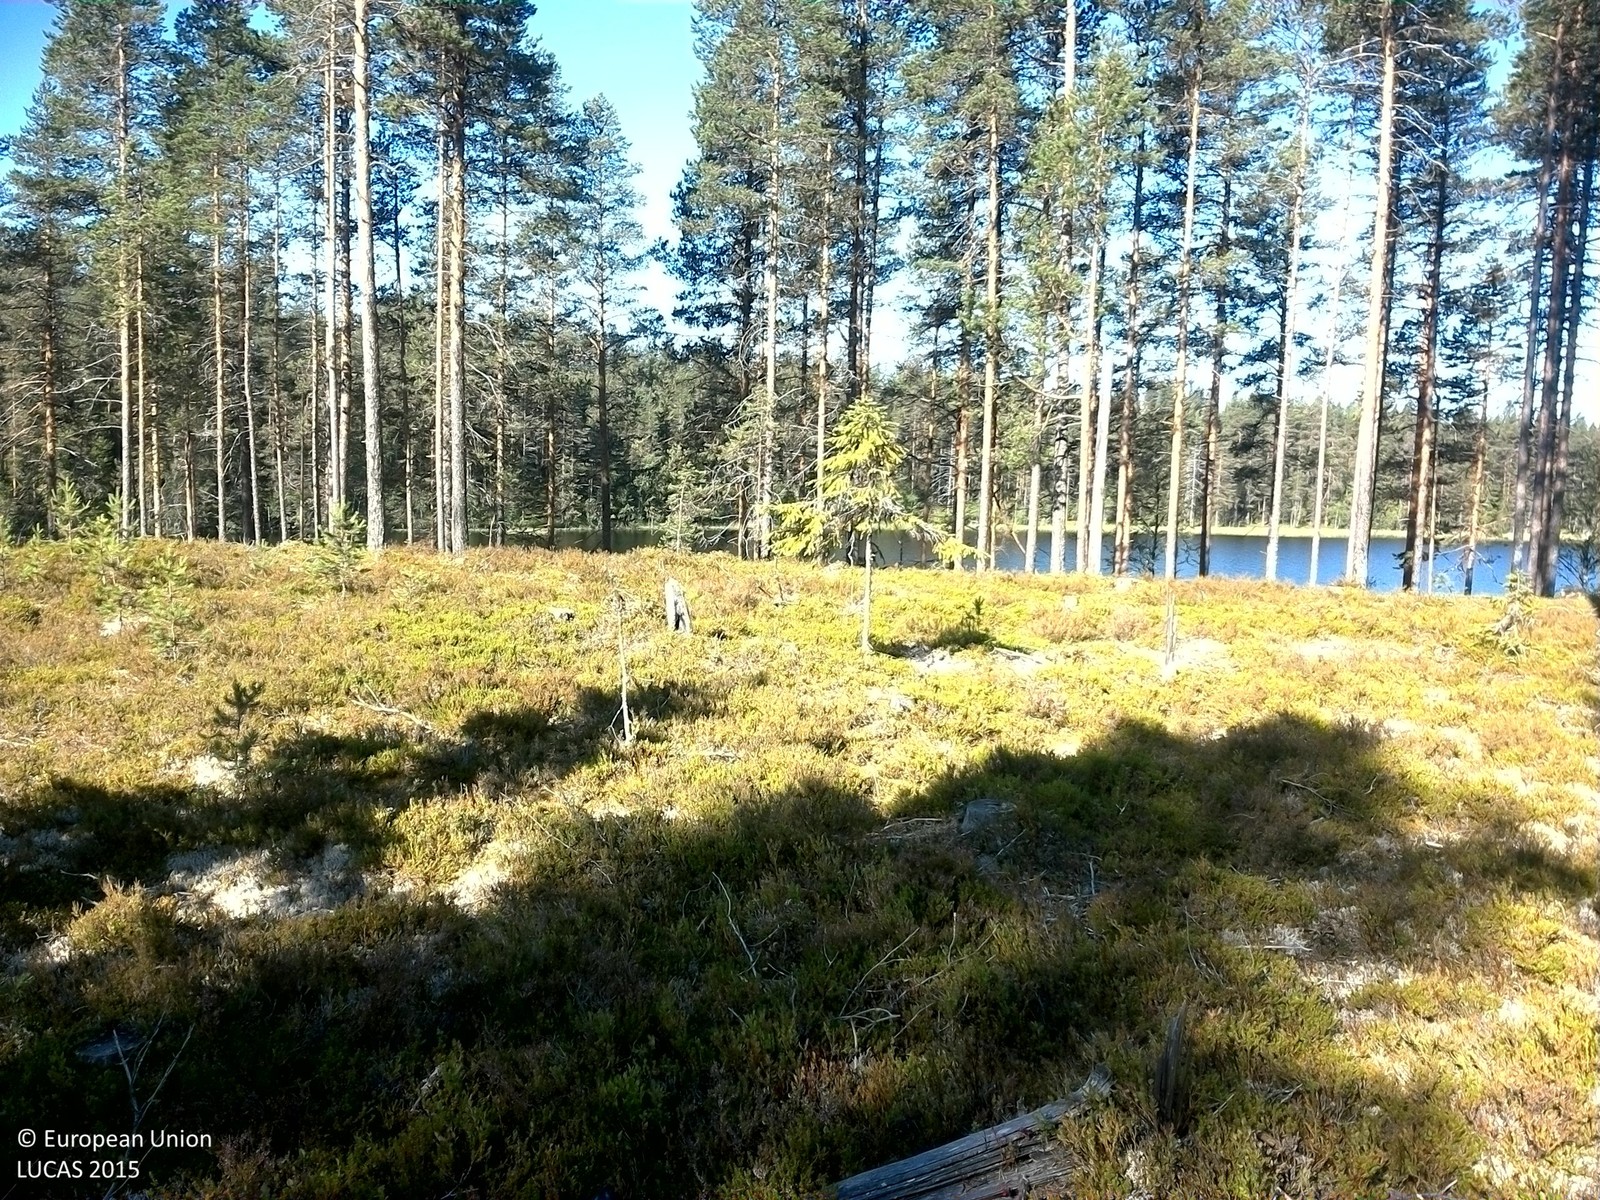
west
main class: Shrubland
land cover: Shrubland with sparse tree cover
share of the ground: 50 - 75 %
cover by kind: shrubs 60 %, lichens and mosses 35 %, coniferous forest trees 5 %
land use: Forestry
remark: Clear cut
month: August
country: SE
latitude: 63.7534
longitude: 16.5997
